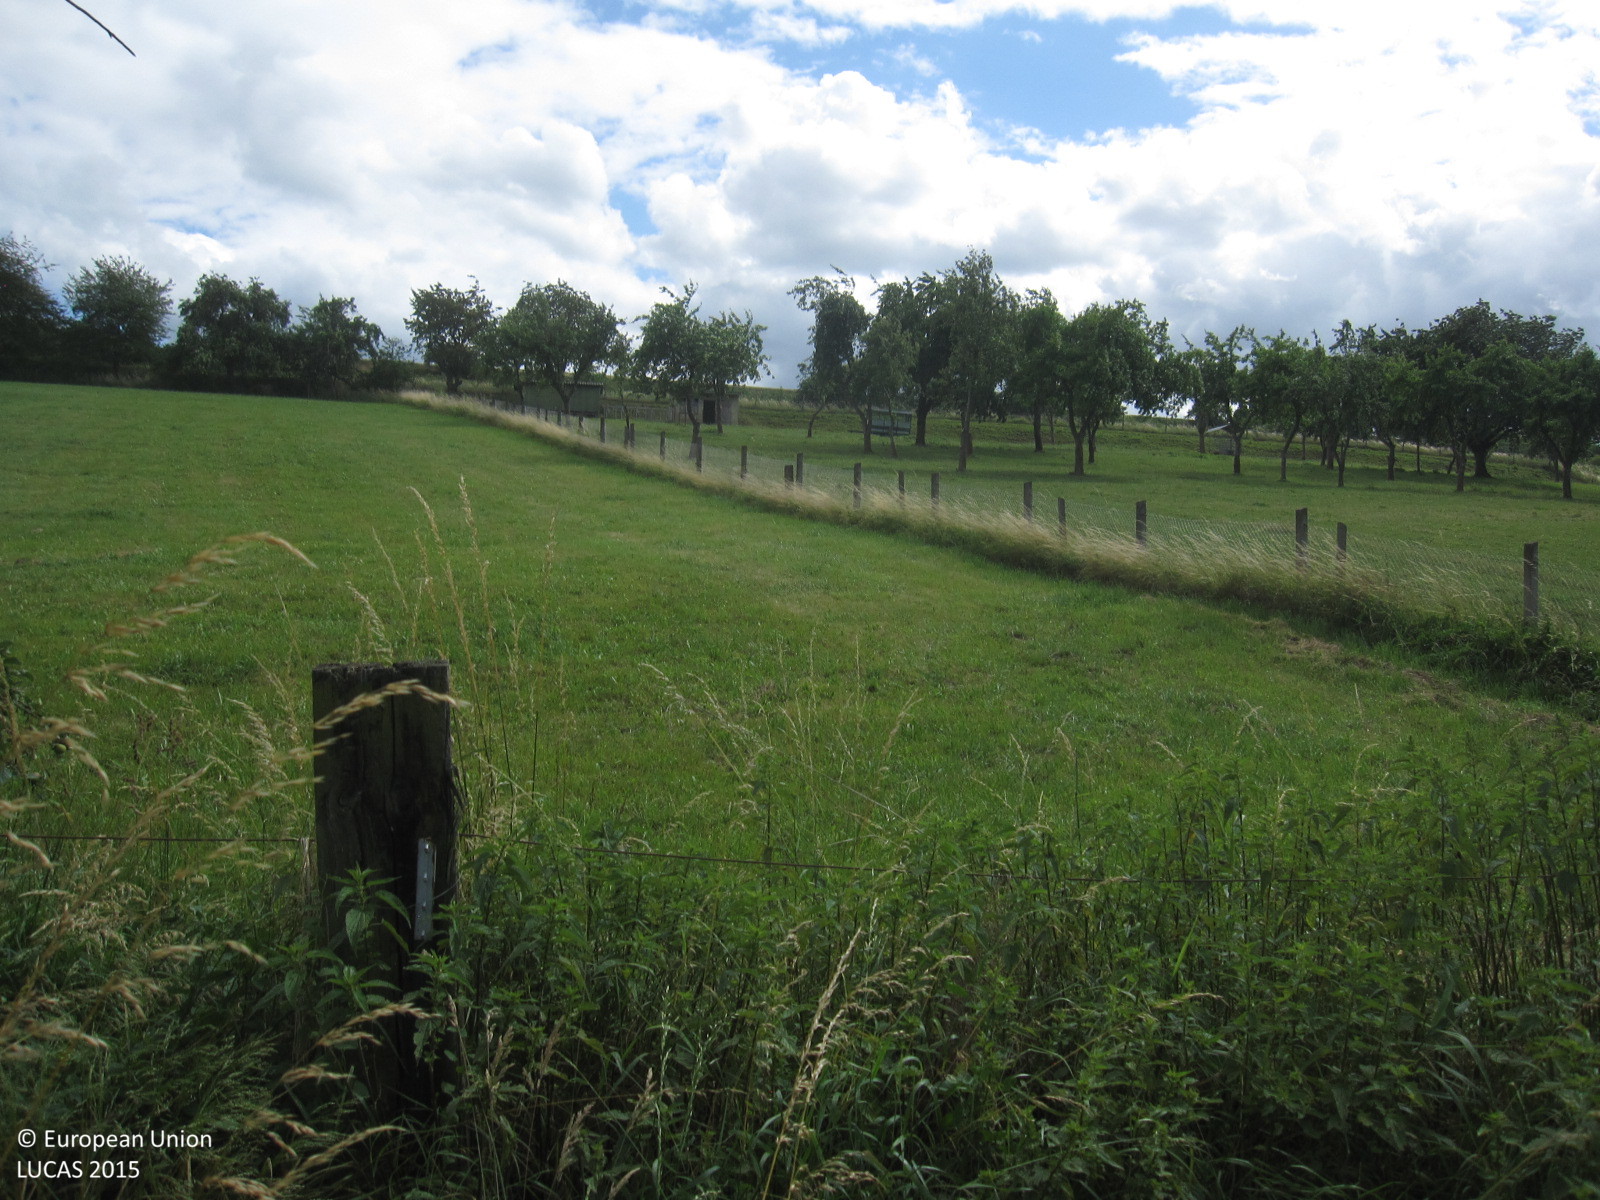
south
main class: Cropland
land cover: Cherry fruit
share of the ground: 50 - 75 %
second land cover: Grassland without tree/shrub cover
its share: > 75 %
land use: Agriculture (excluding fallow land and kitchen gardens)
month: July
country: DE
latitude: 50.9580
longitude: 12.0070
